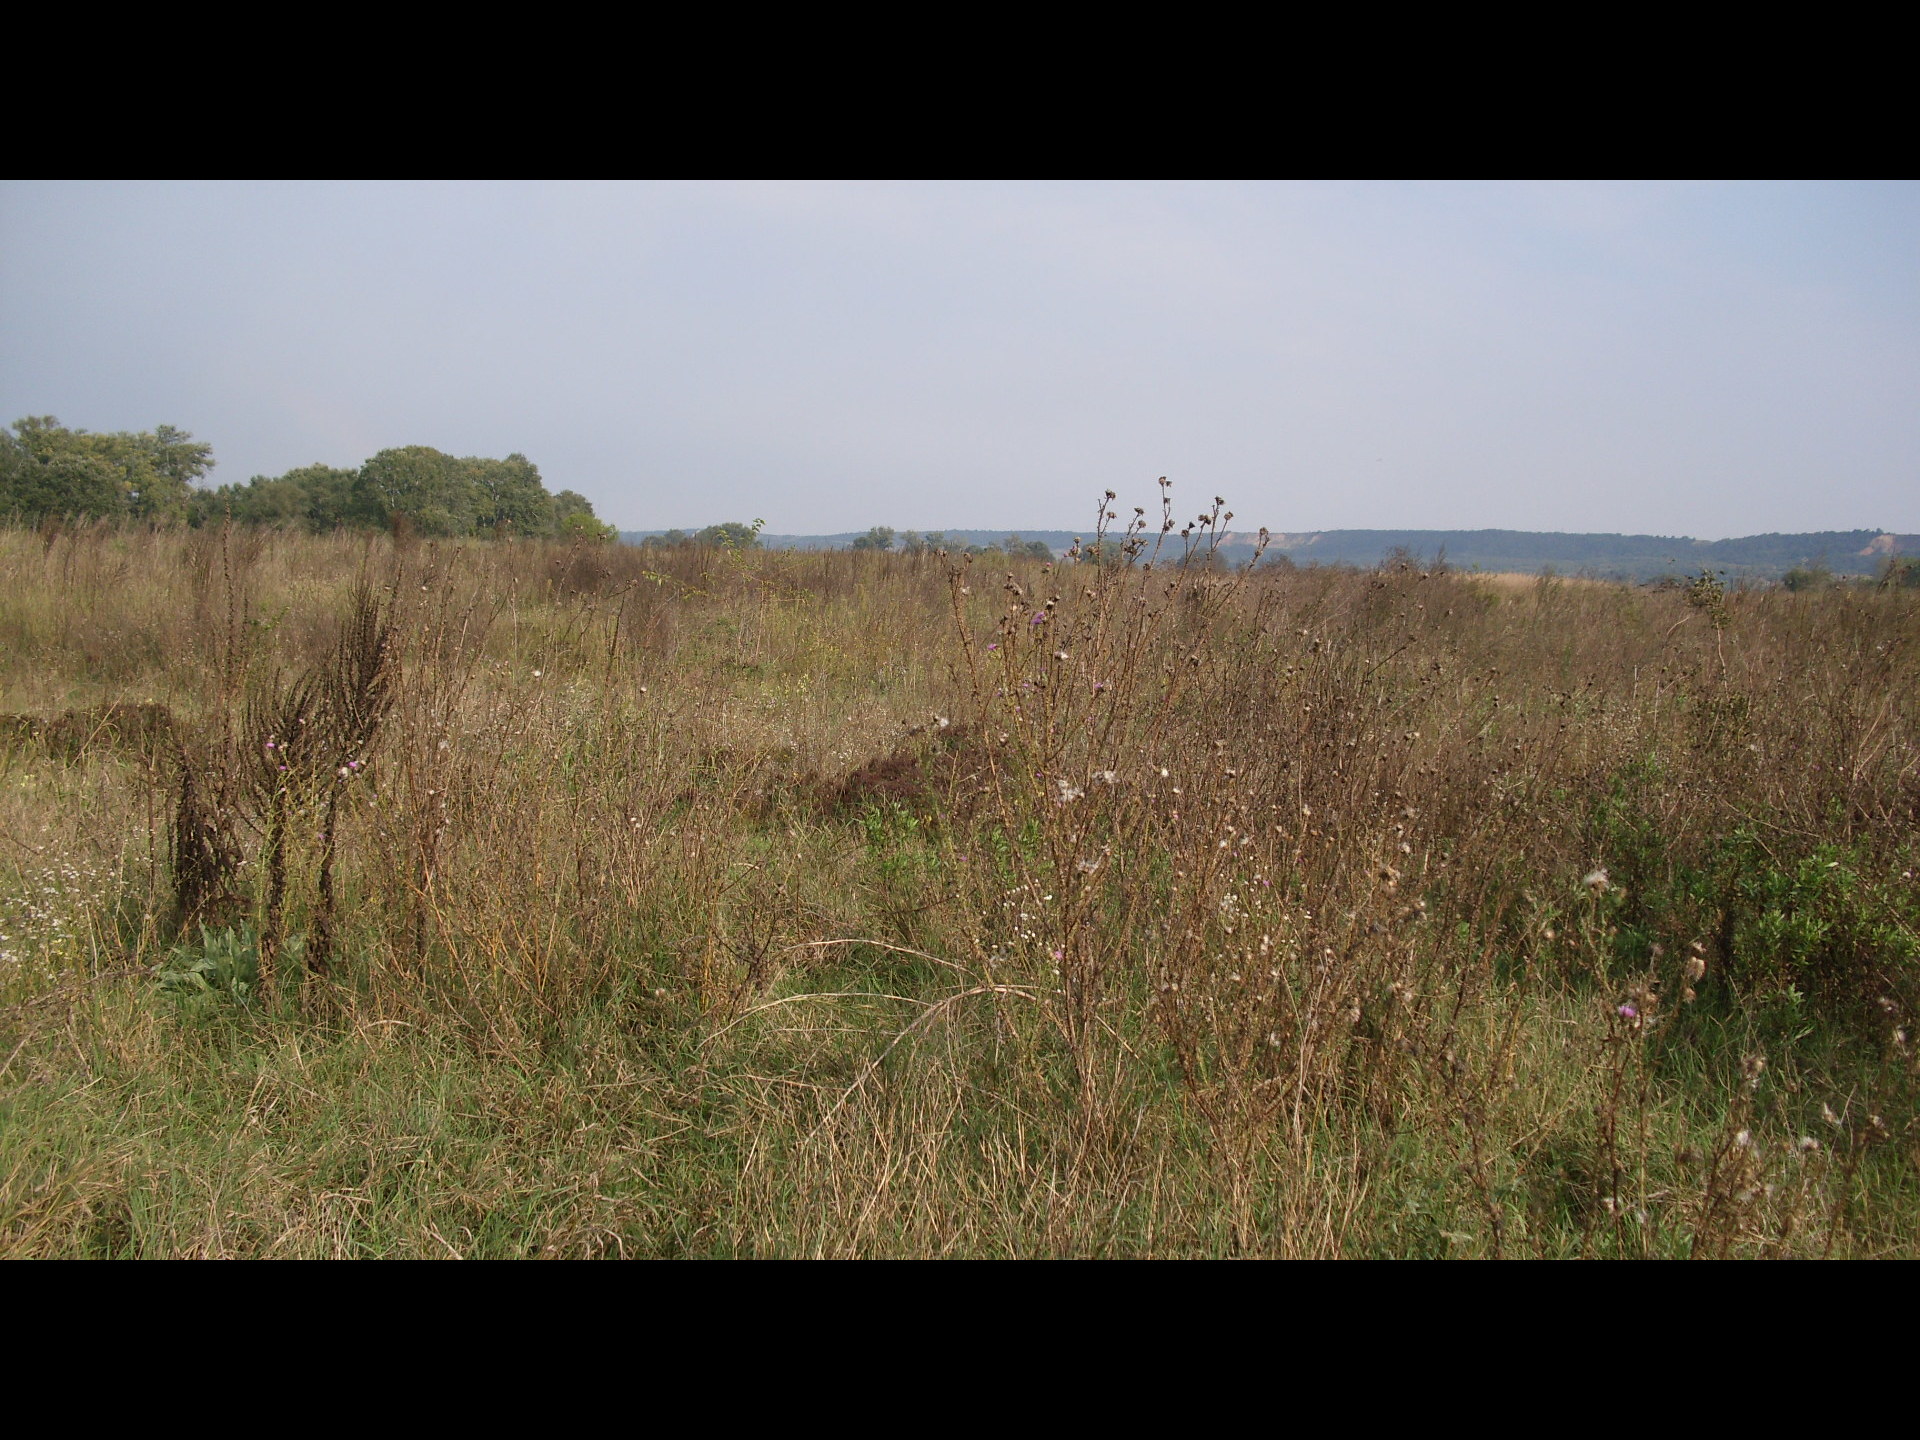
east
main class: Grassland
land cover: Spontaneously vegetated surfaces
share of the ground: > 75 %
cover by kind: herbaceous plants 100 %
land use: Abandoned areas
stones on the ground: < 10 %
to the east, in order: Spontaneously vegetated surfaces
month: September
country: BG
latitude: 43.7813
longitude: 23.0244
